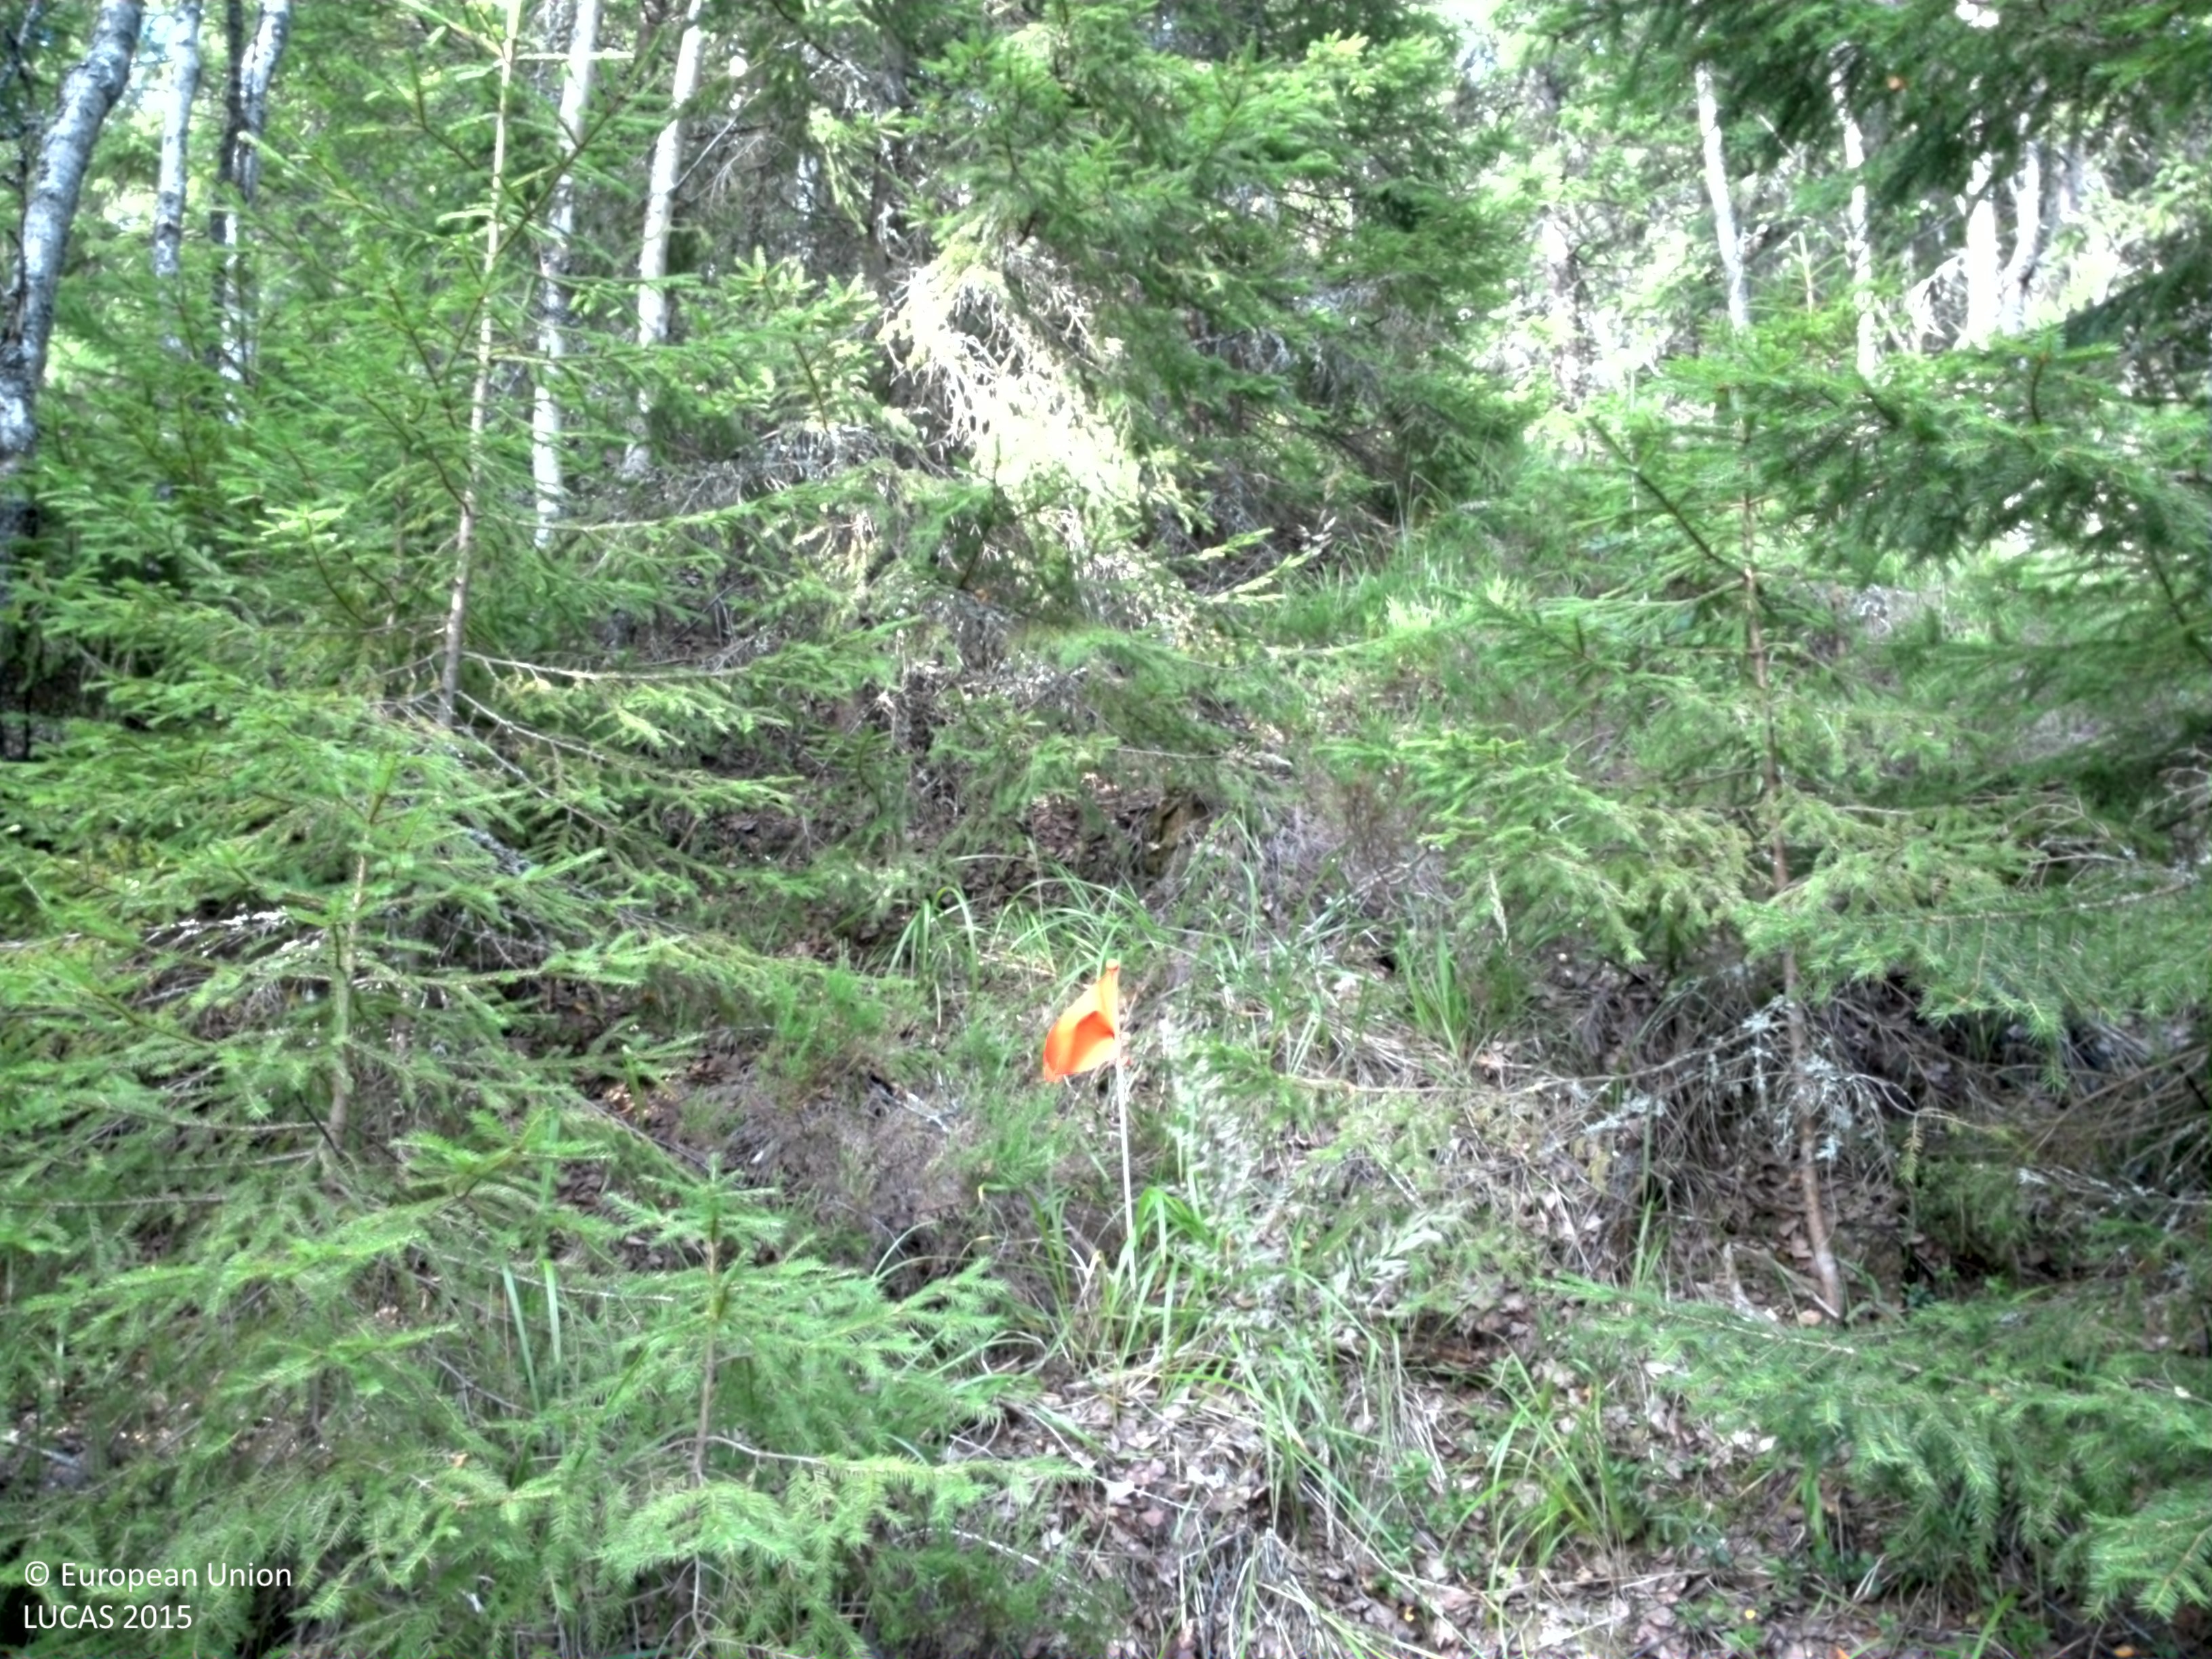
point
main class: Woodland
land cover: Spruce dominated mixed woodland
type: boreal forest
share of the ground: 50 - 75 %
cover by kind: coniferous forest trees 35 %, herbaceous plants 30 %, broadleaved forest trees 15 %, consolidated bare surface 10 %, shrubs 5 %, lichens and mosses 5 %
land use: Forestry
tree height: > 5 m
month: August
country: SE
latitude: 60.0088
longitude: 14.2404
